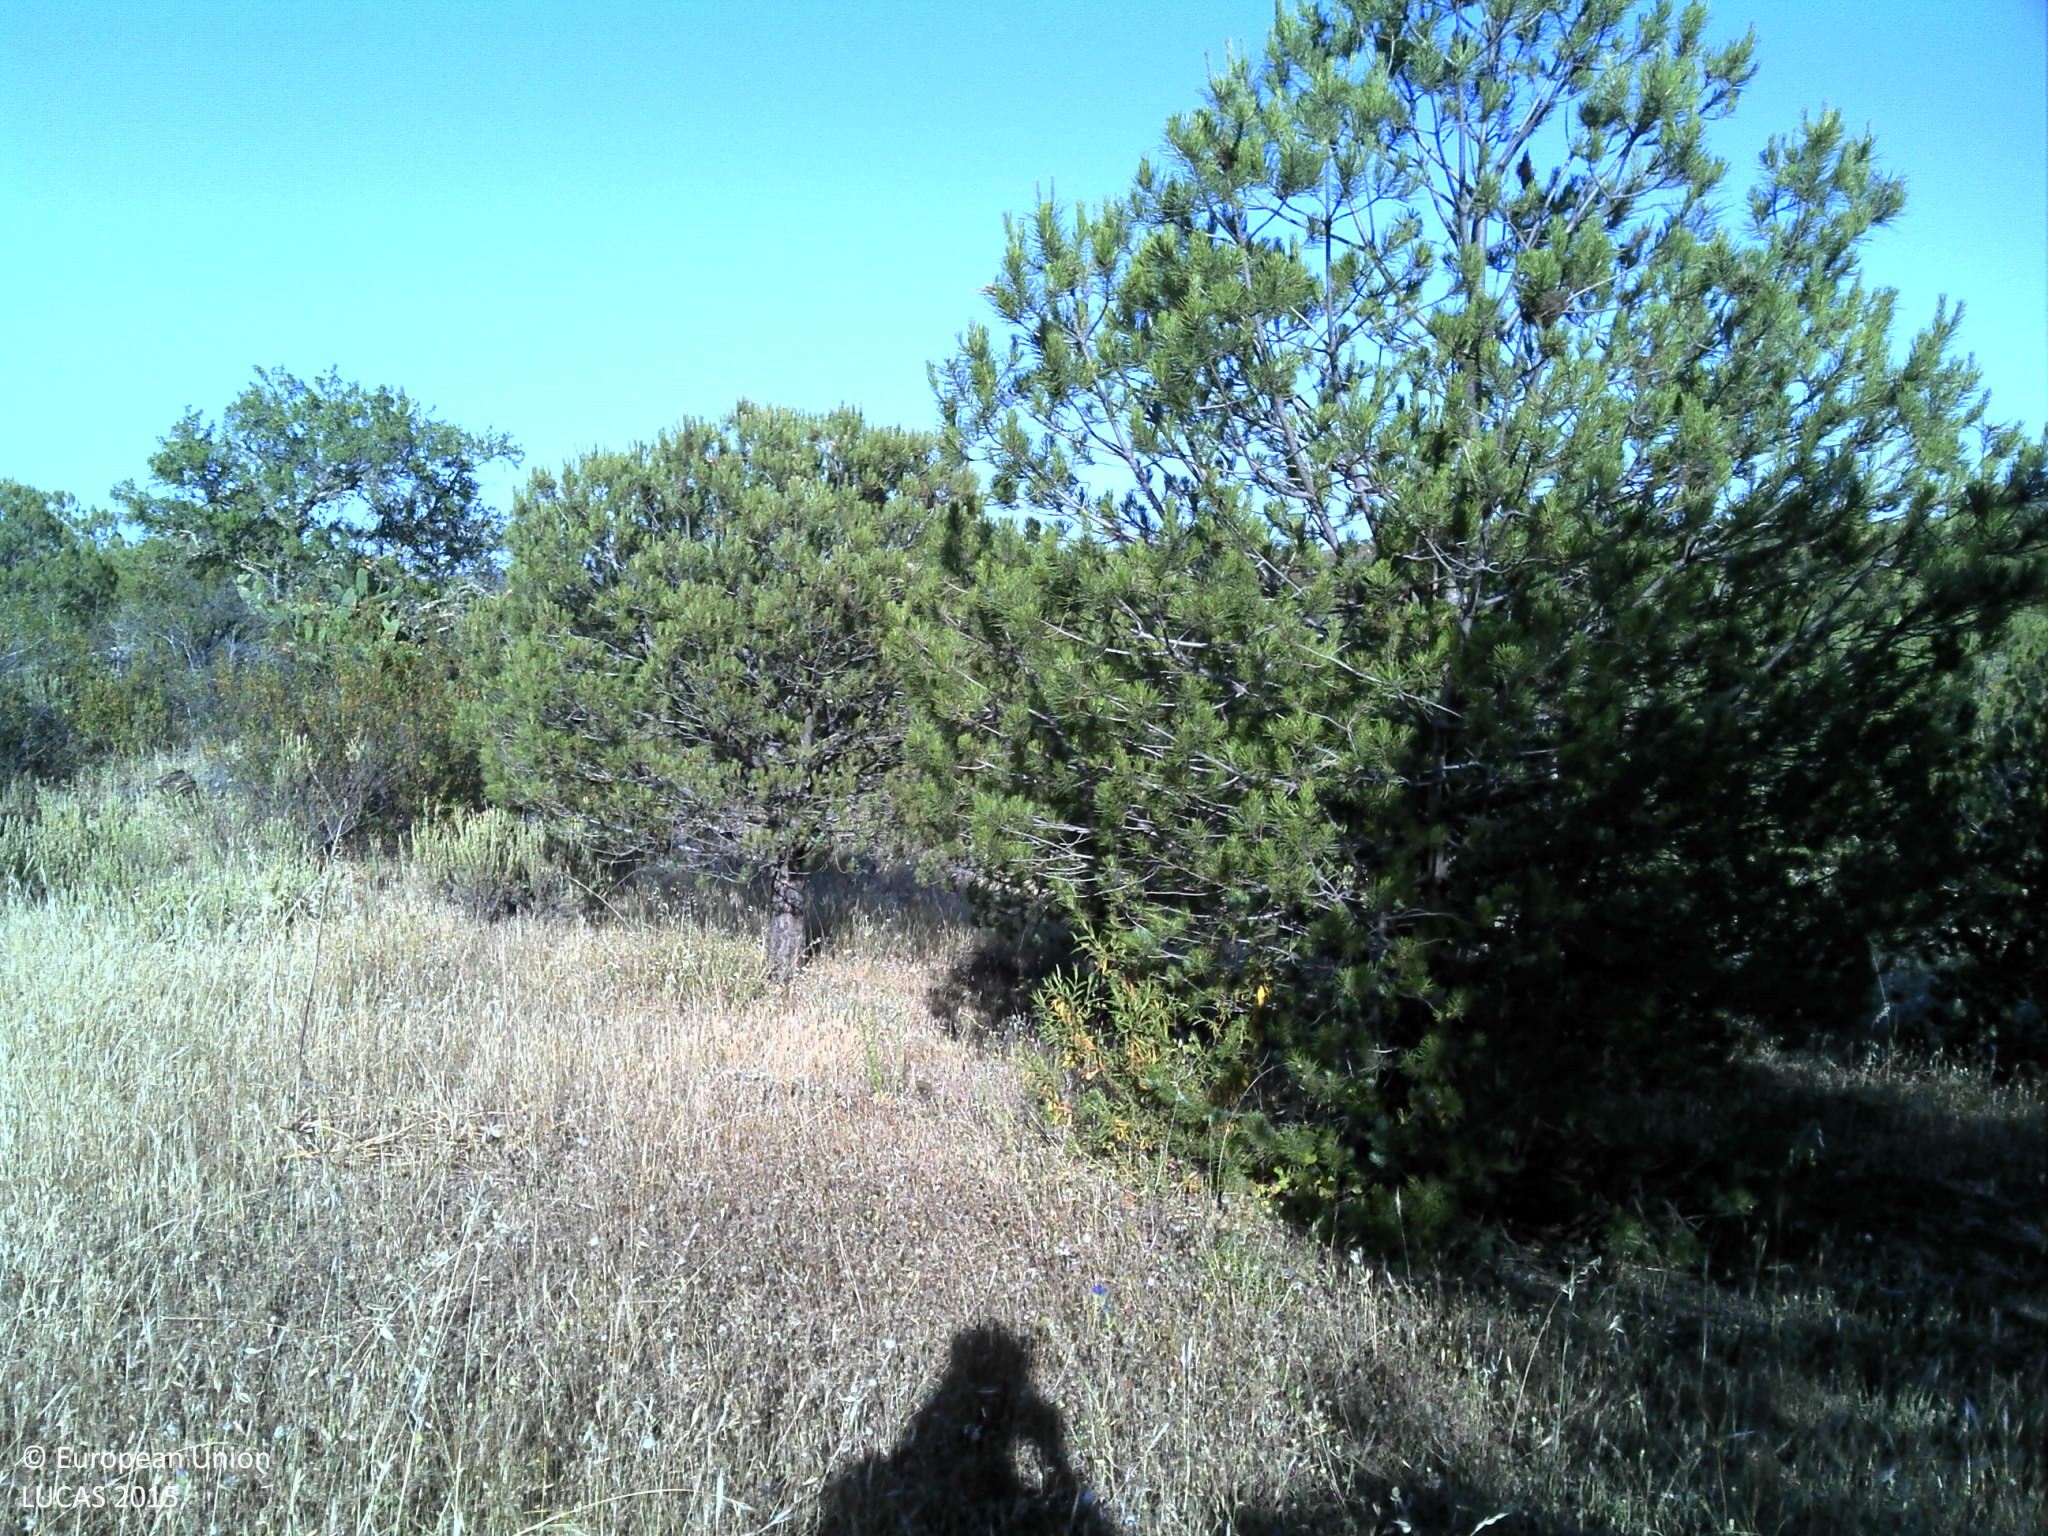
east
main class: Woodland
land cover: Pine dominated coniferous woodland
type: coniferous forest of the mediterranean region
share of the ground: 25 - 50 %
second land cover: Grassland without tree/shrub cover
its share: 50 - 75 %
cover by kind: herbaceous plants 40 %, coniferous forest trees 35 %, shrubs 25 %
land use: Forestry
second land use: Agriculture (excluding fallow land and kitchen gardens)
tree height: < 5 m
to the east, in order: Pine dominated coniferous woodland; Grassland without tree/shrub cover; Pine dominated coniferous woodland; Shrubland without tree cover; Dry stone walls; Grassland without tree/shrub cover; Pine dominated coniferous woodland; Dry stone walls; Grassland without tree/shrub cover; Shrubland without tree cover
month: May
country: PT
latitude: 37.4439
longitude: -7.4938
